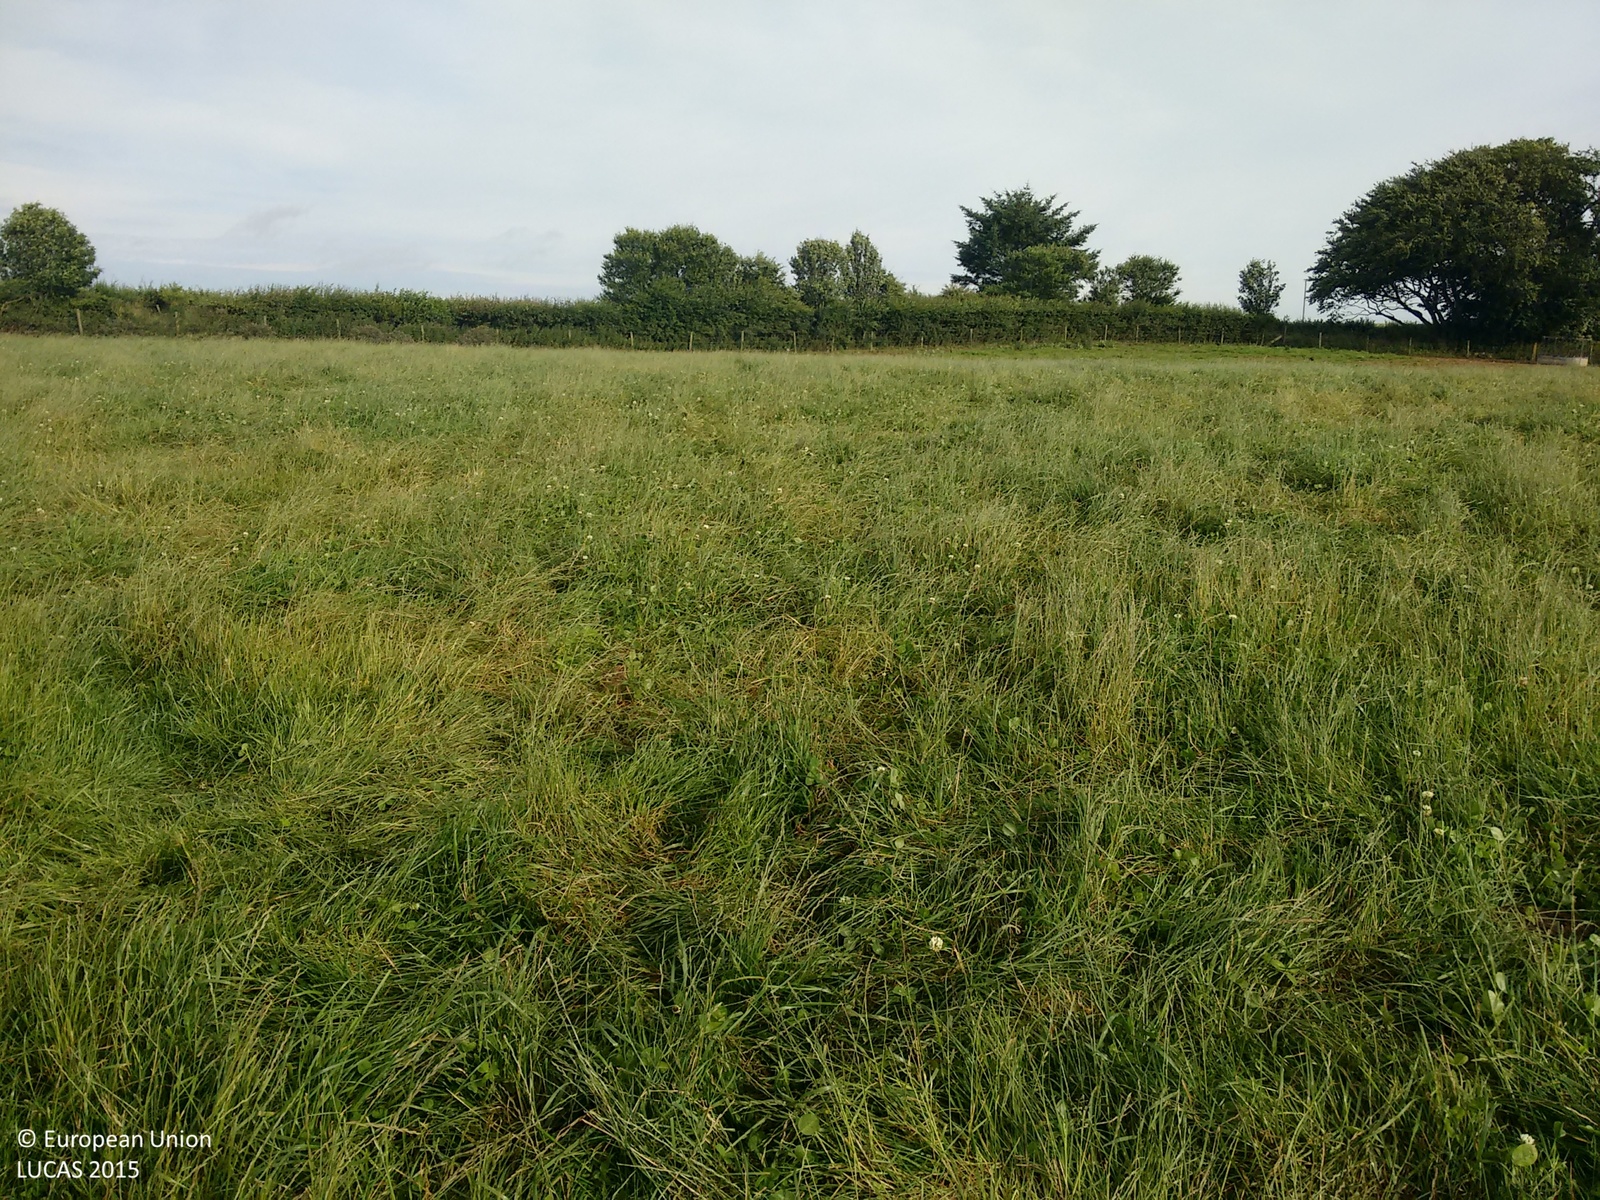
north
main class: Grassland
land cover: Grassland without tree/shrub cover
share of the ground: > 75 %
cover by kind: herbaceous plants 100 %
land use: Agriculture (excluding fallow land and kitchen gardens)
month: August
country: GB
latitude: 57.5345
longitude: -2.1908
